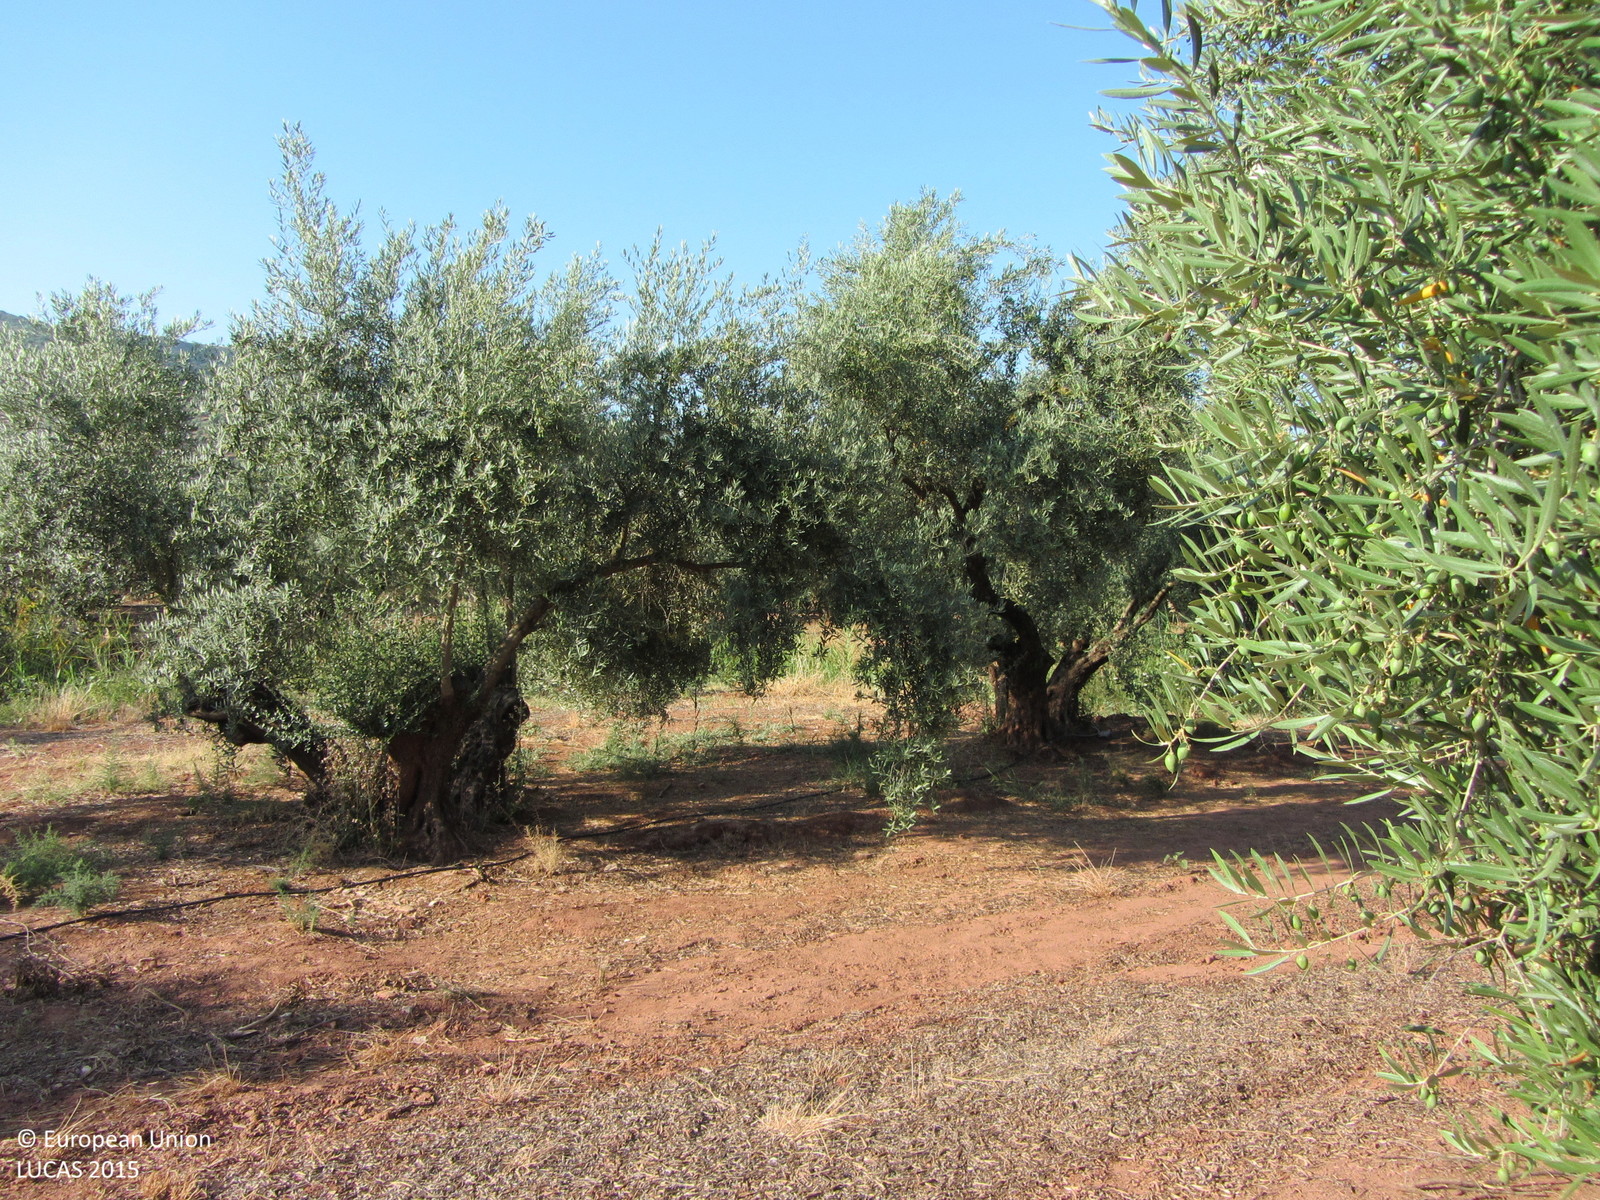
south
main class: Cropland
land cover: Olive groves
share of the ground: 25 - 50 %
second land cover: Other bare soil
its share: > 75 %
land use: Agriculture (excluding fallow land and kitchen gardens)
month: June
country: ES
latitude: 38.1864
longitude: -3.4180
